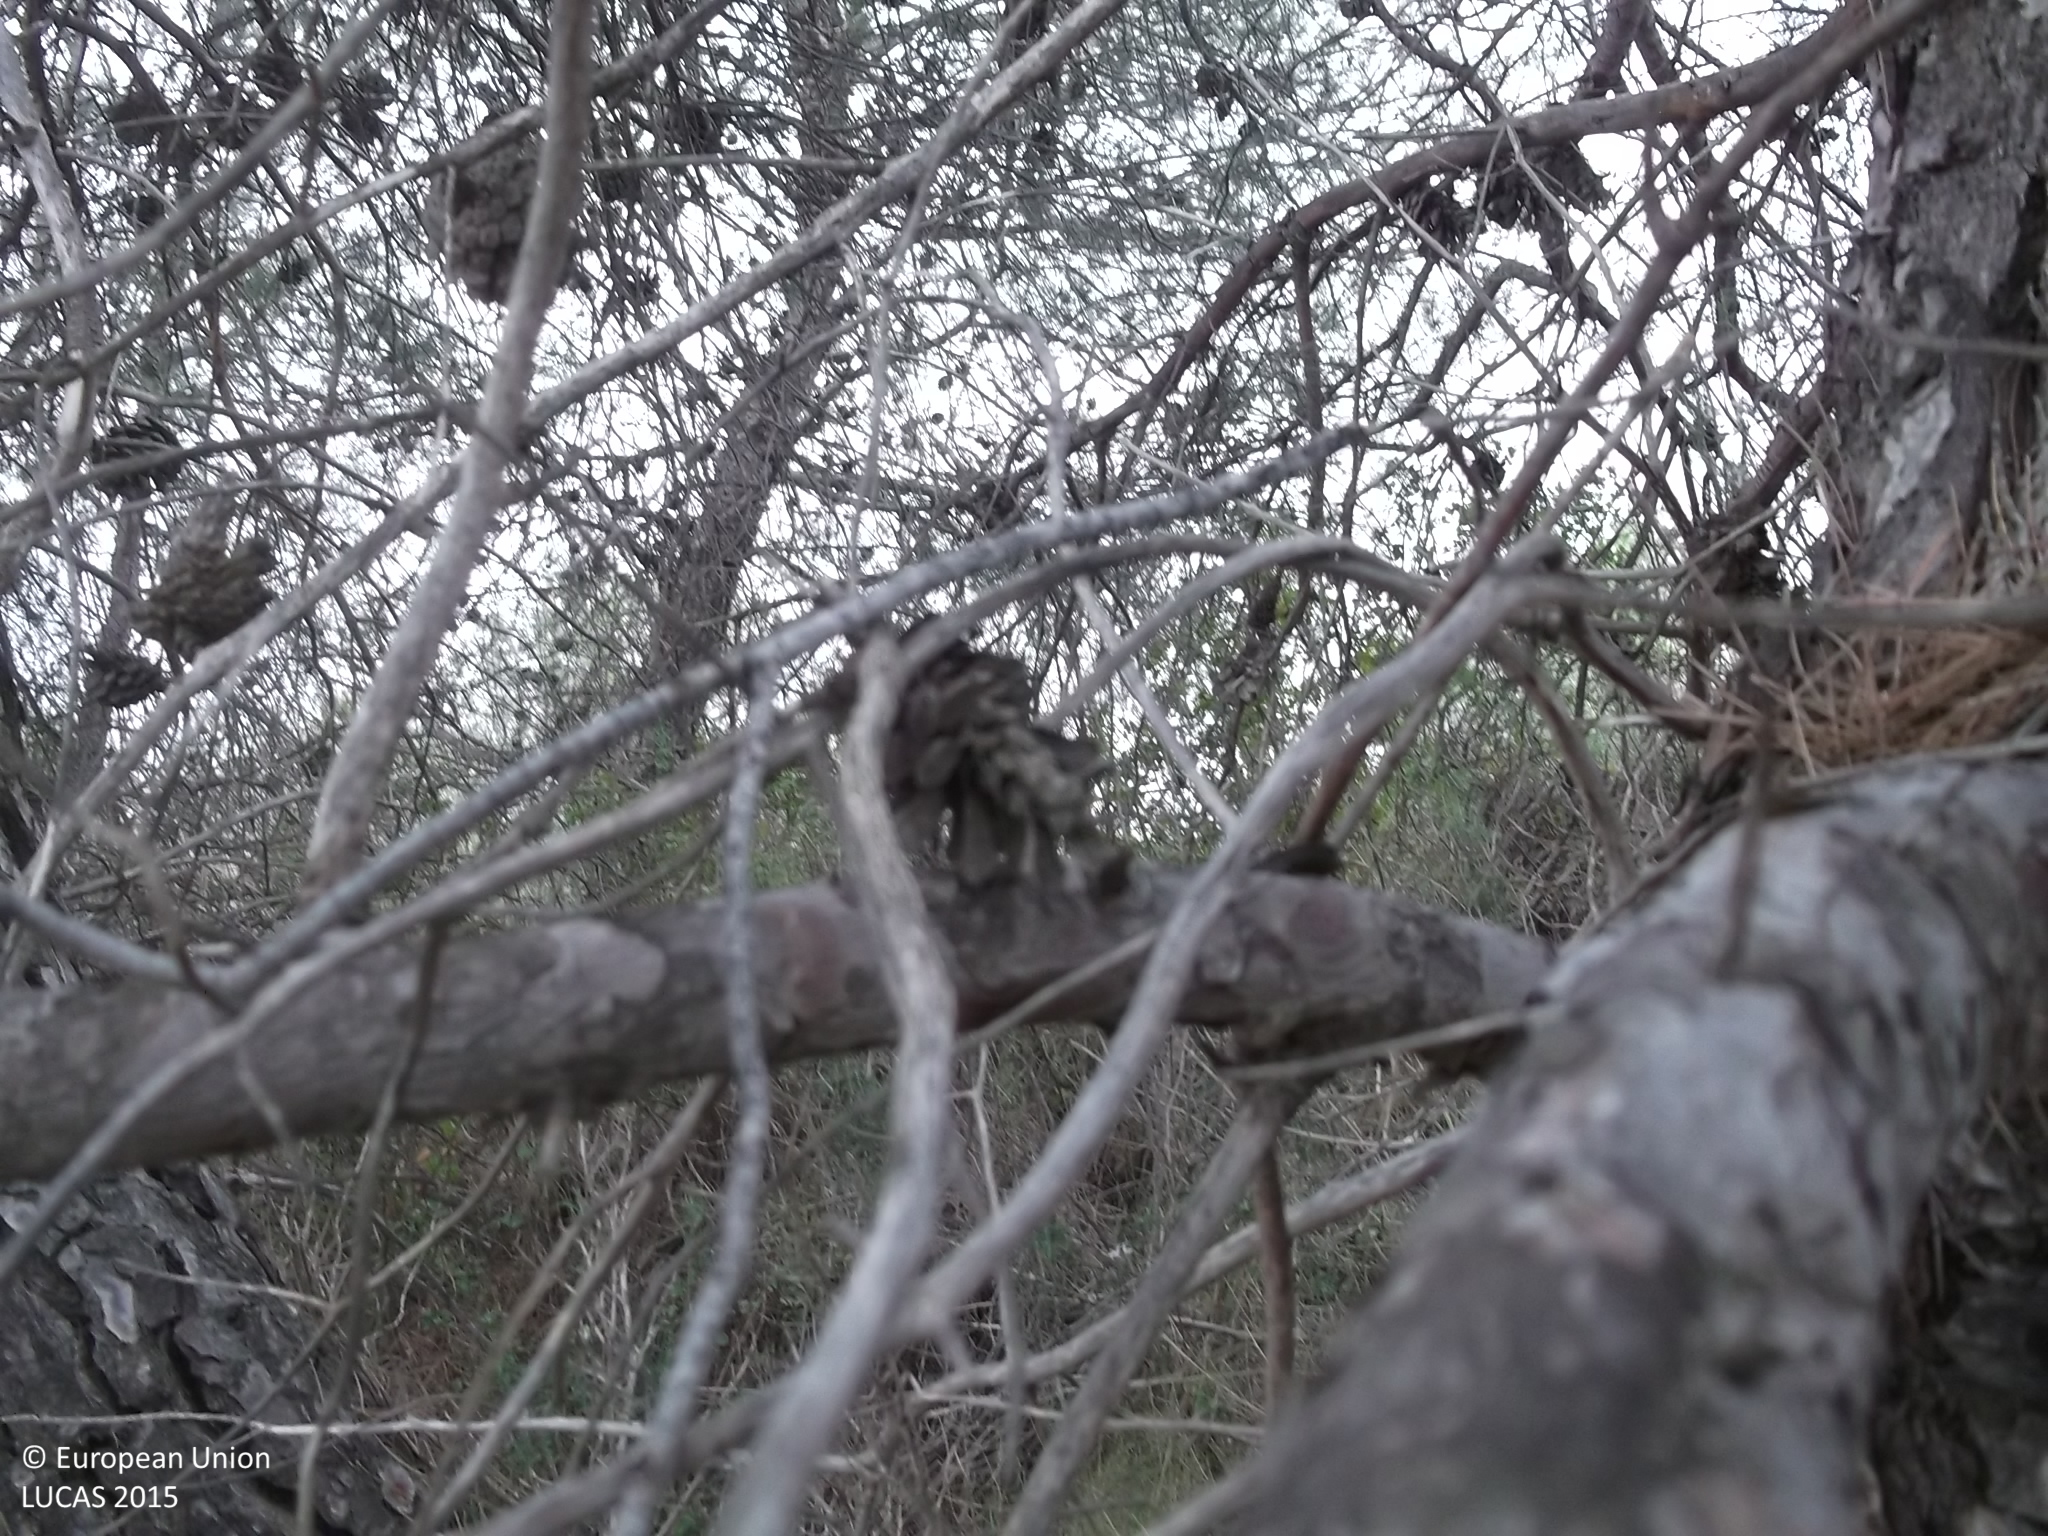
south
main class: Woodland
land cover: Pine dominated coniferous woodland
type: coniferous forest of the mediterranean region
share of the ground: 10 - 25 %
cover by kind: coniferous forest trees 50 %, shrubs 50 %
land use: Semi-natural and natural areas not in use
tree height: > 5 m
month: April
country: ES
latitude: 38.0060
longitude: -1.5917
